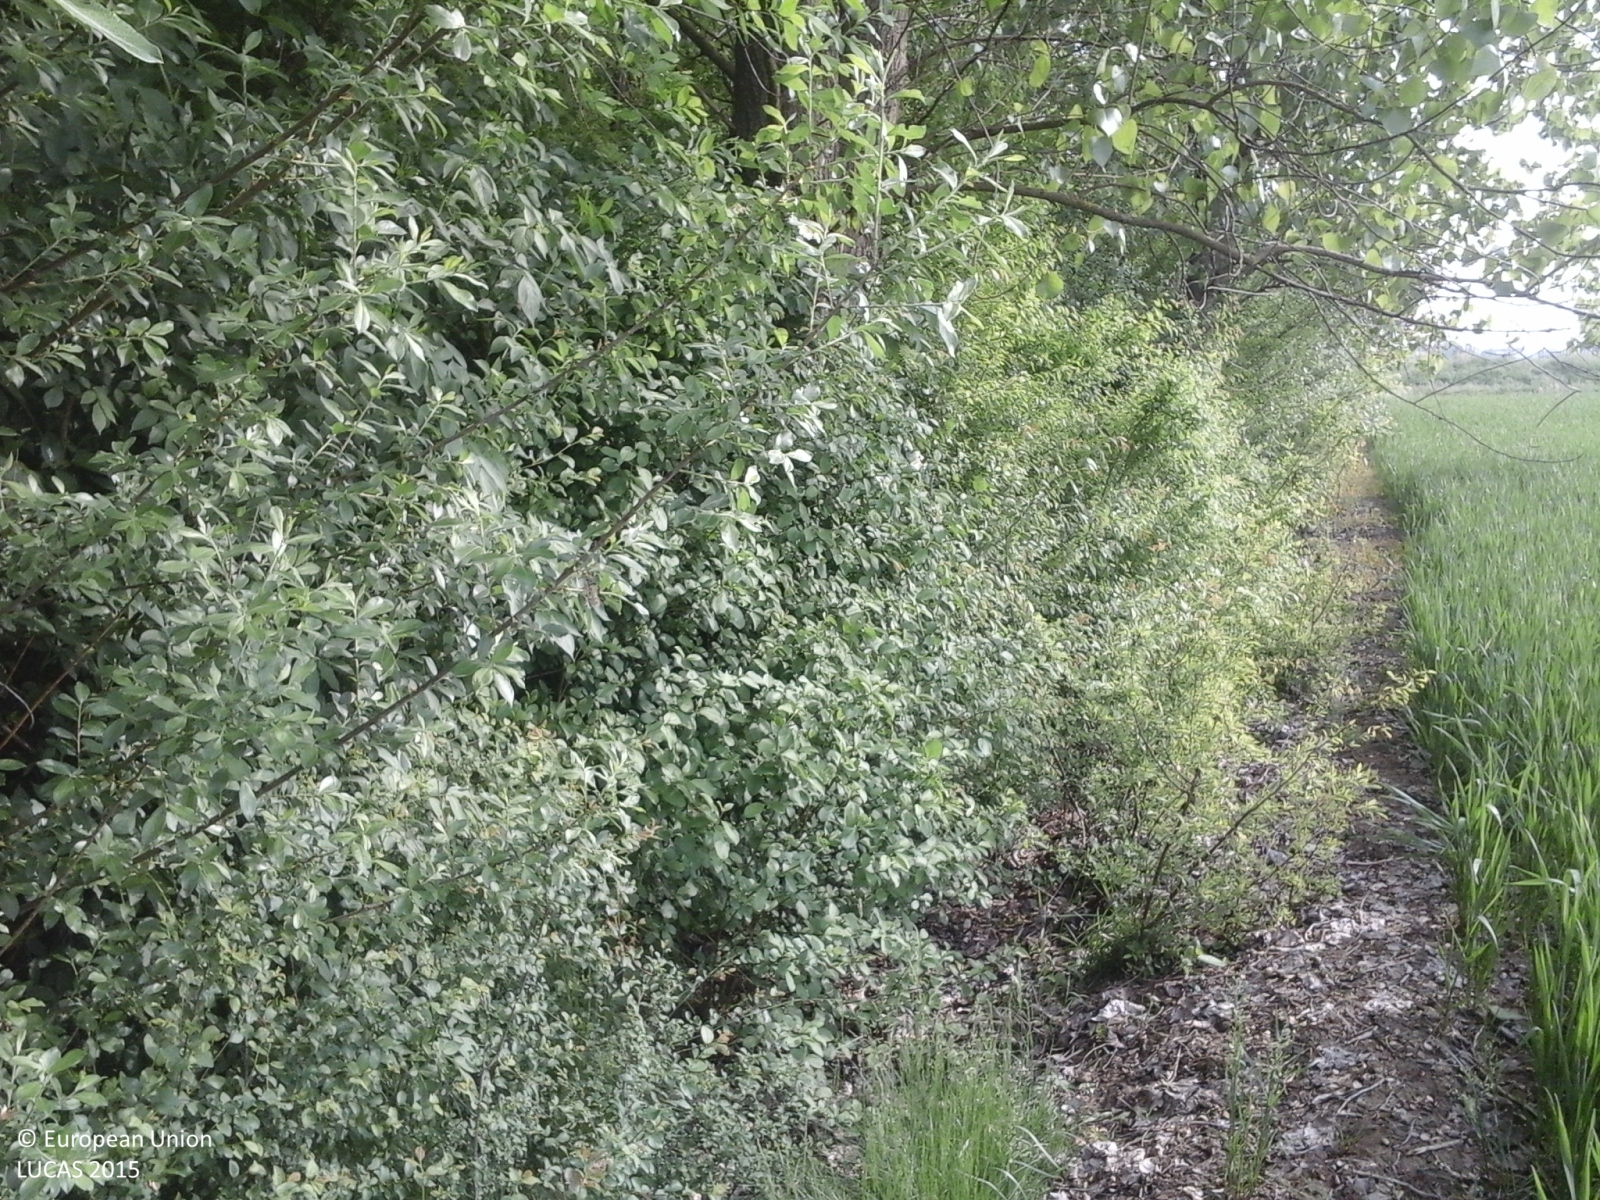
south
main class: Cropland
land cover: Common wheat
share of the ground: > 75 %
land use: Agriculture (excluding fallow land and kitchen gardens)
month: April
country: IT
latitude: 44.7256
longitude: 10.8694
